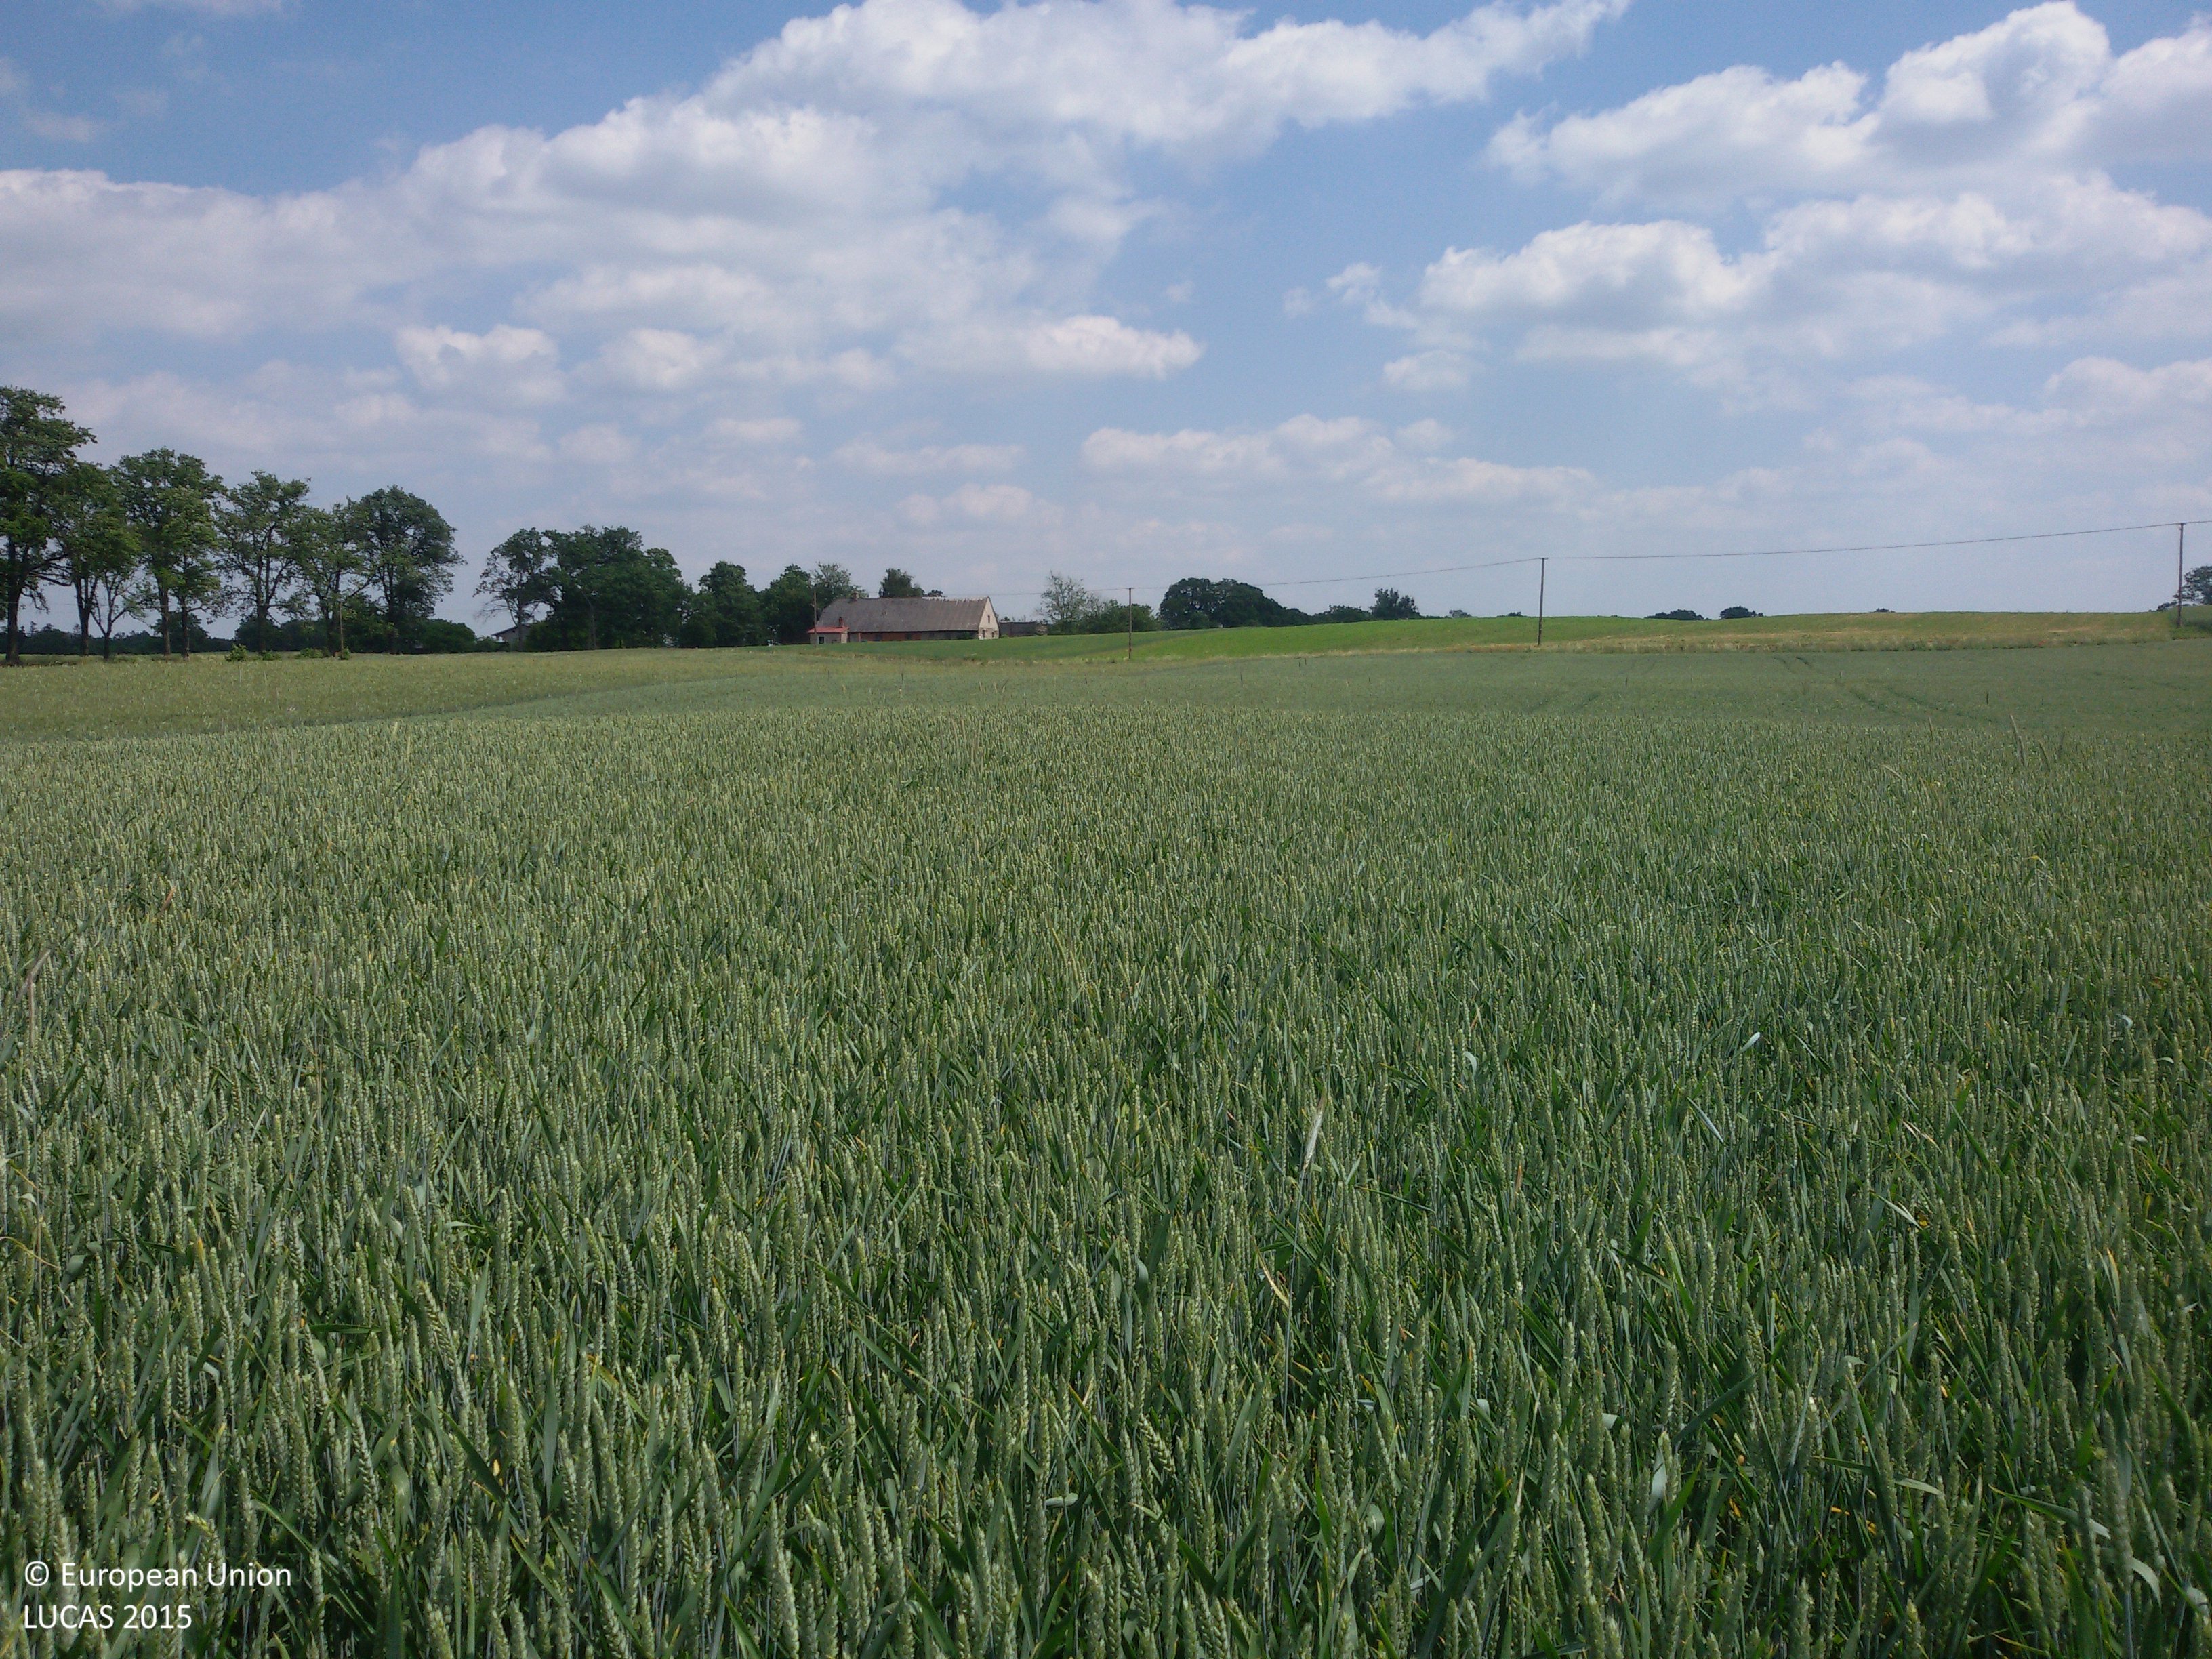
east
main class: Cropland
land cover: Common wheat
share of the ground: > 75 %
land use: Agriculture (excluding fallow land and kitchen gardens)
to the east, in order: Common wheat; Triticale; Grass margins; Tracks; Grass margins; Lucerne; Electric lines; Lucerne
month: June
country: PL
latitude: 53.3935
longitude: 17.6670
